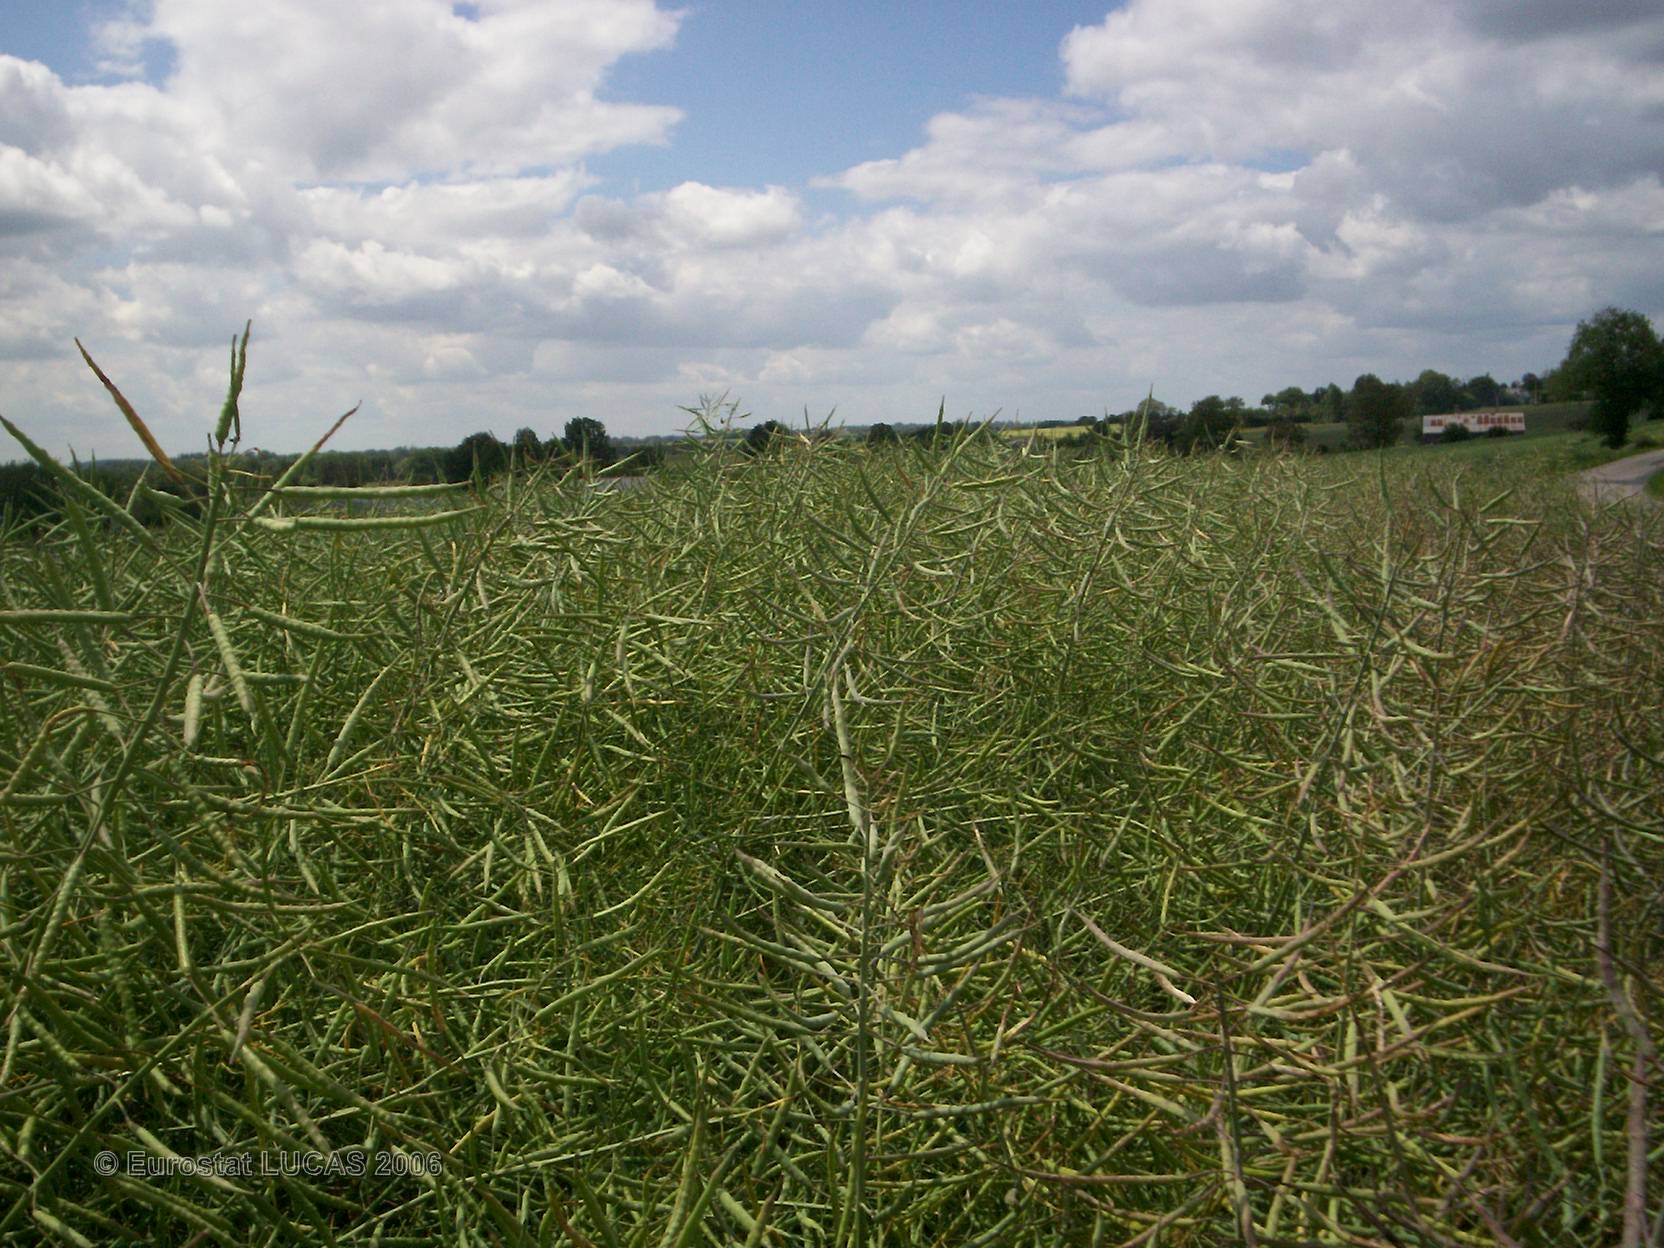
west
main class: Cropland
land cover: Rape and turnip rape
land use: Agriculture (excluding fallow land and kitchen gardens)
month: May
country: FR
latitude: 47.5842
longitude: -1.1412
